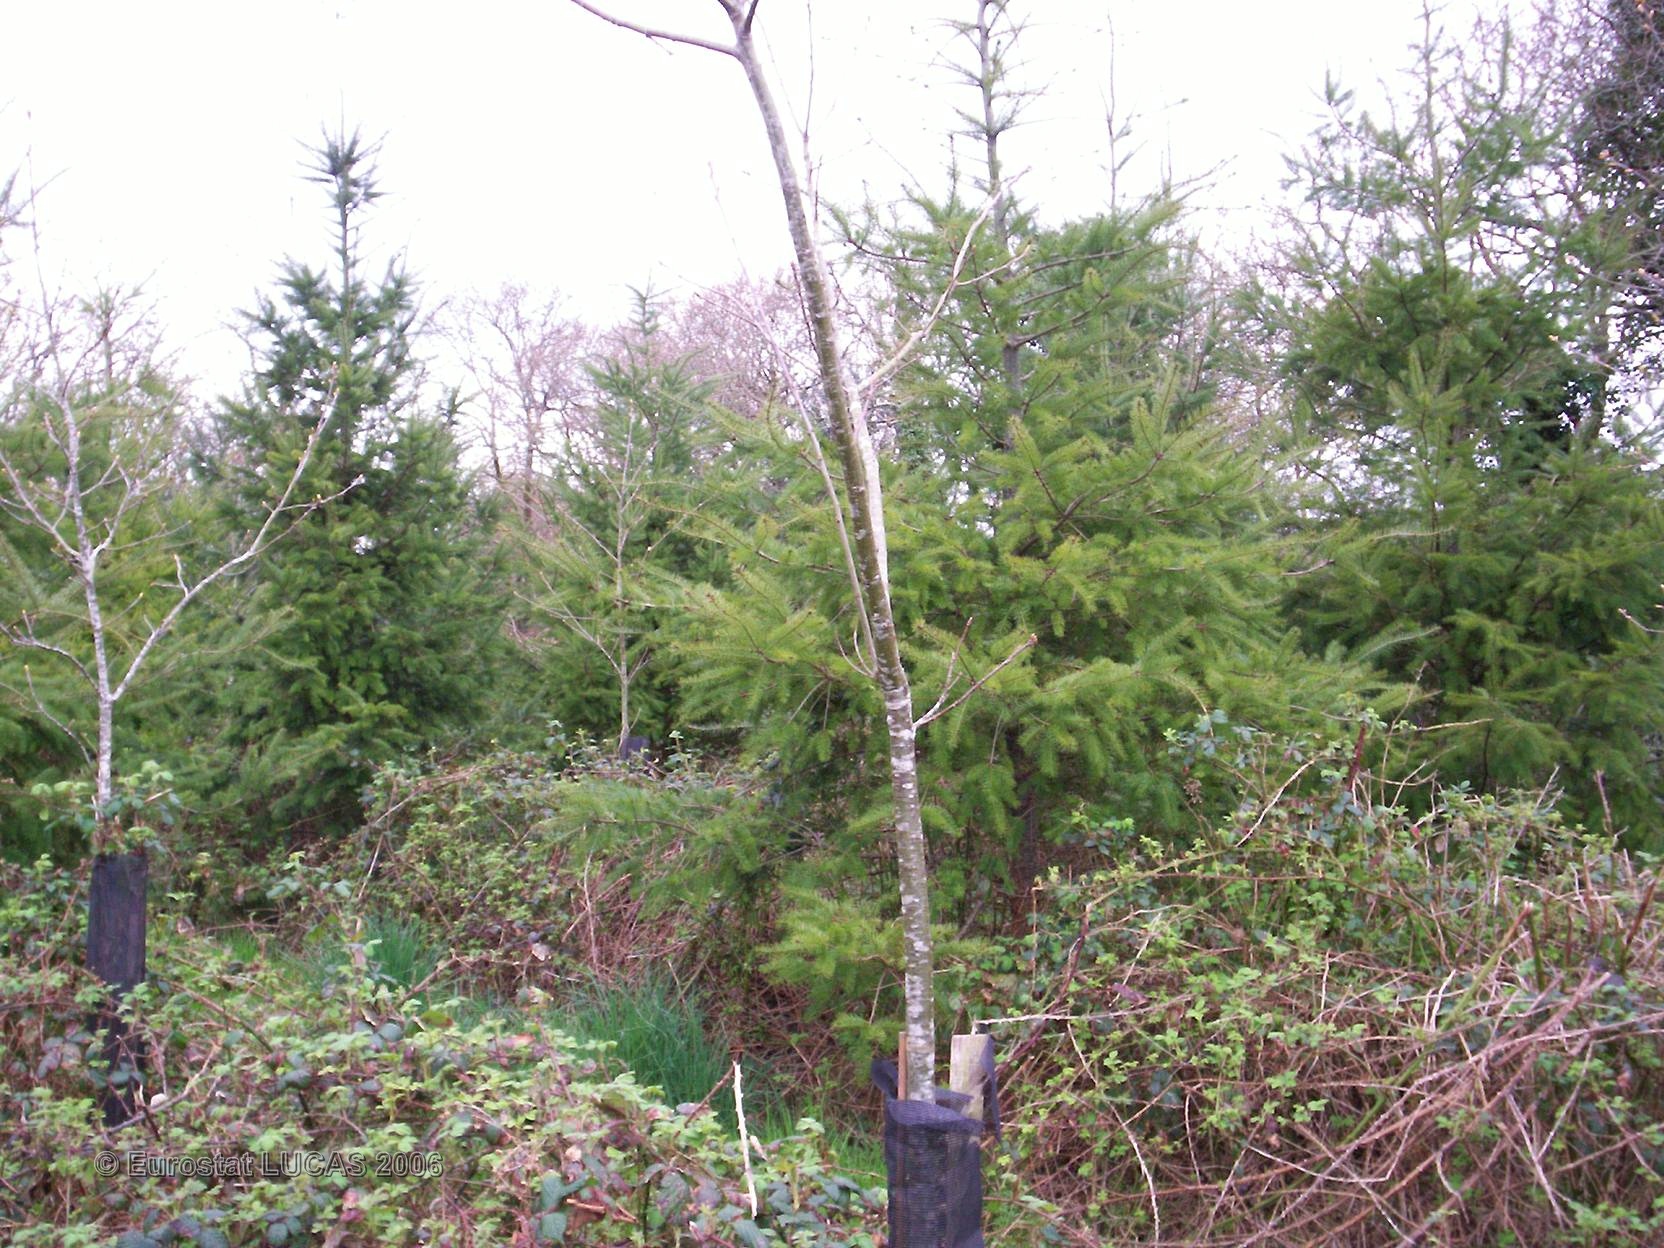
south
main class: Woodland
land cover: Coniferous forest
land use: Forestry
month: April
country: FR
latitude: 47.9961
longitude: -3.6007
